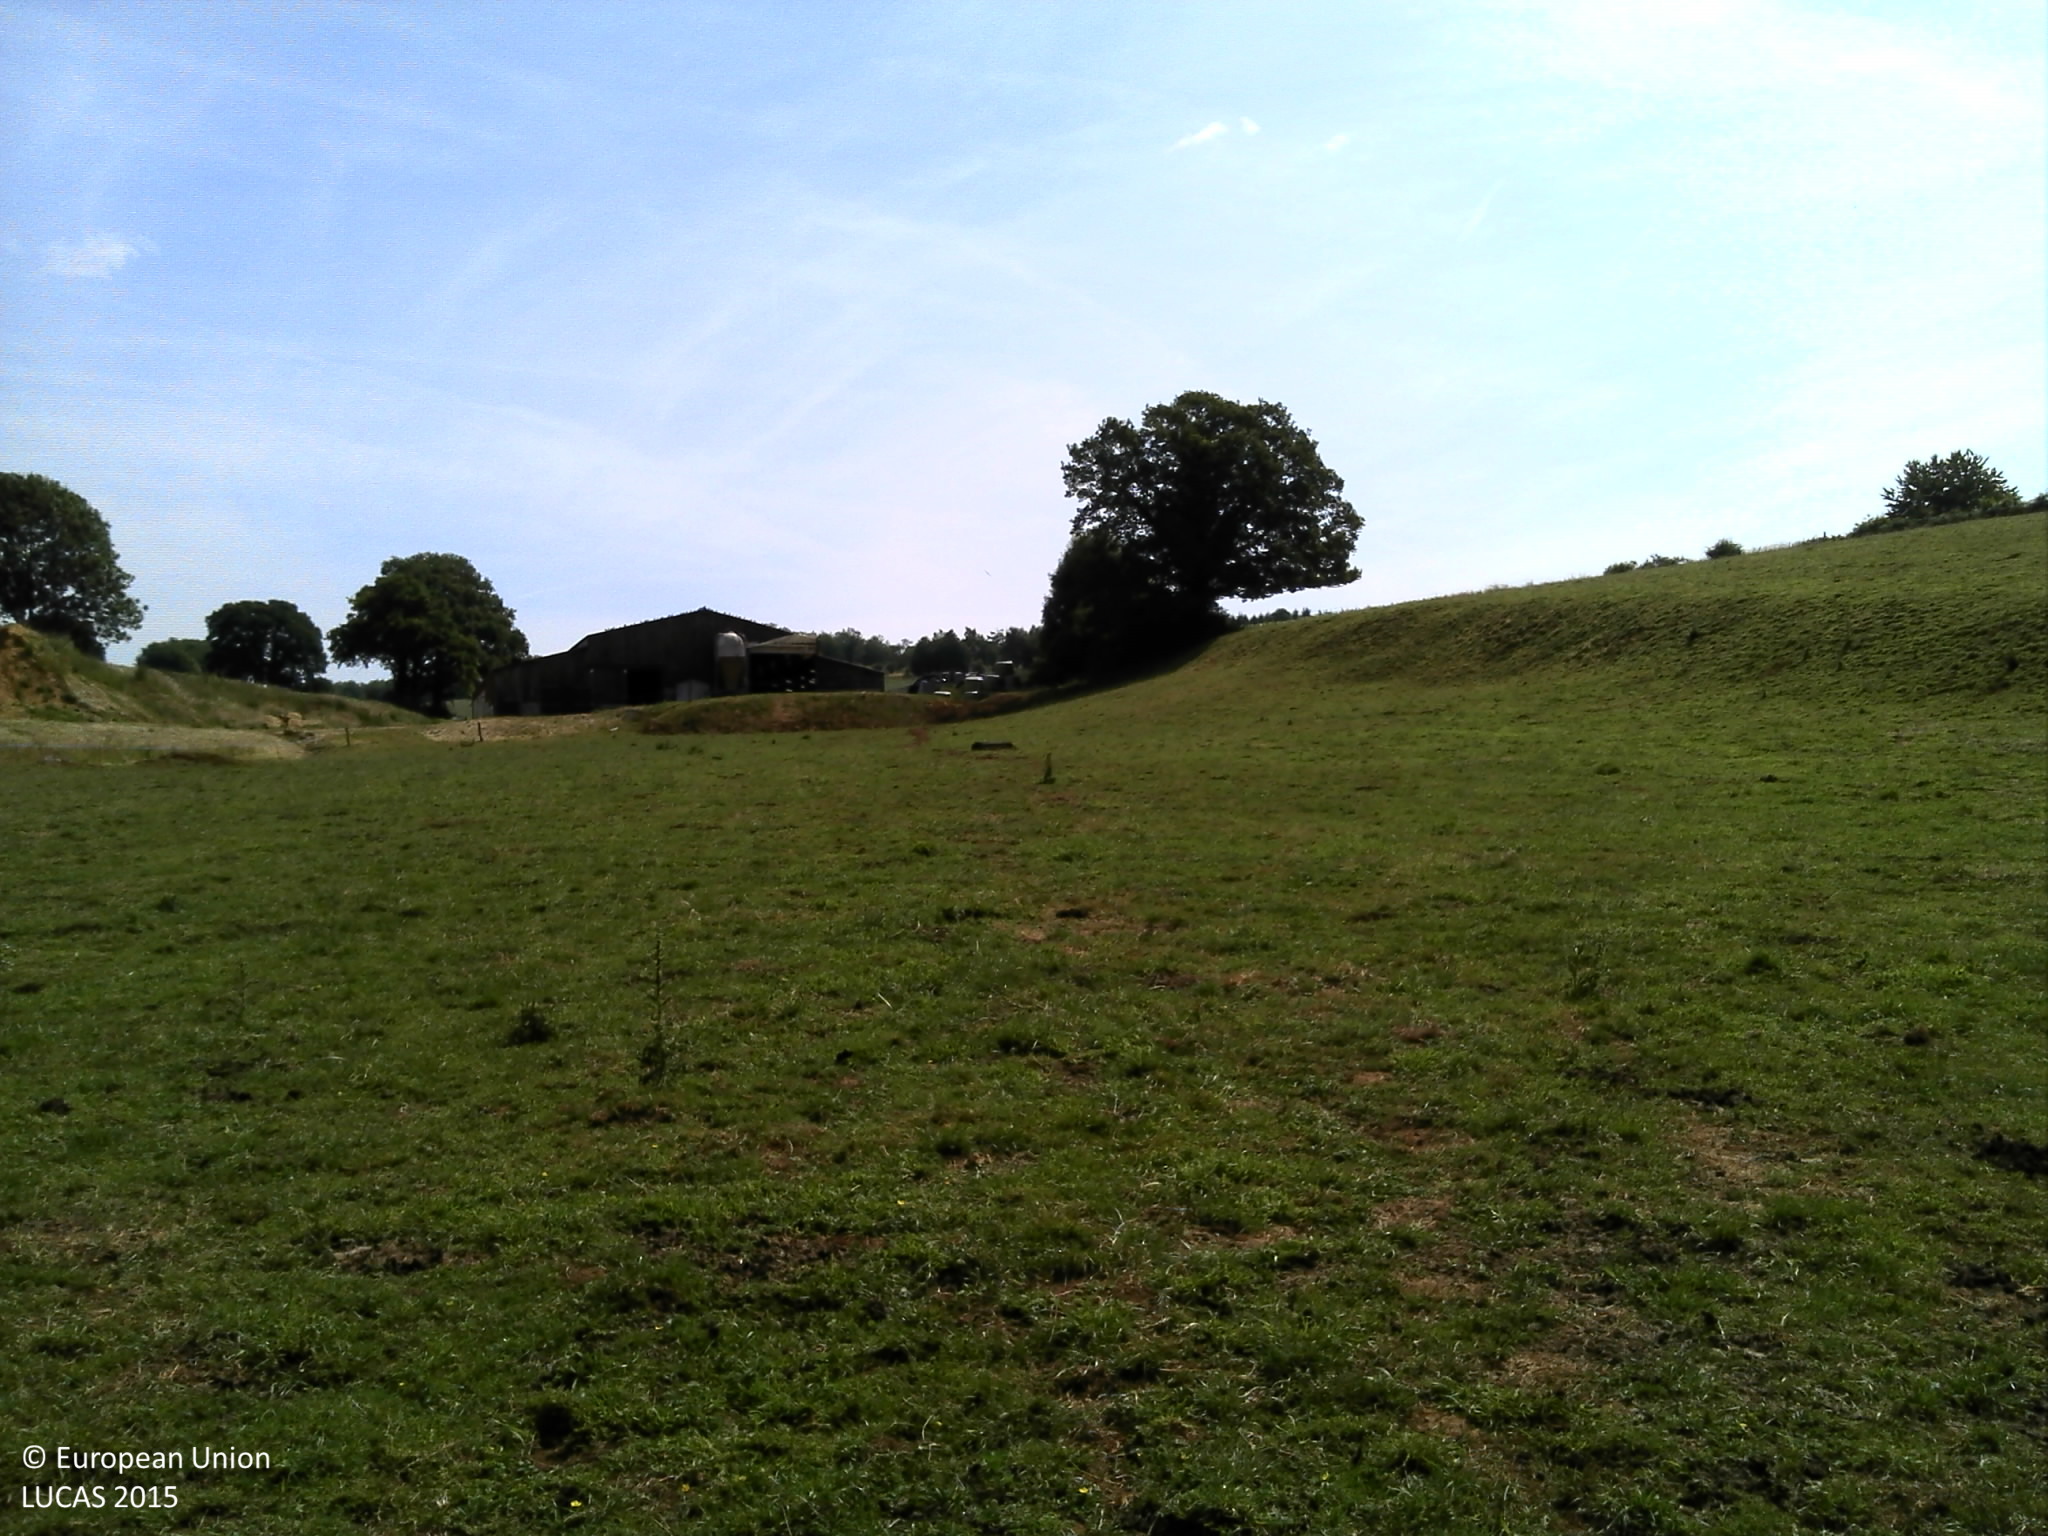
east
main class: Grassland
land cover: Grassland without tree/shrub cover
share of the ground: > 75 %
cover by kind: herbaceous plants 100 %
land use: Agriculture (excluding fallow land and kitchen gardens)
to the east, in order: Grassland without tree/shrub cover; Single bushes/trees; Fences; Maize
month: June
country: FR
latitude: 49.6959
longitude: 4.9927
